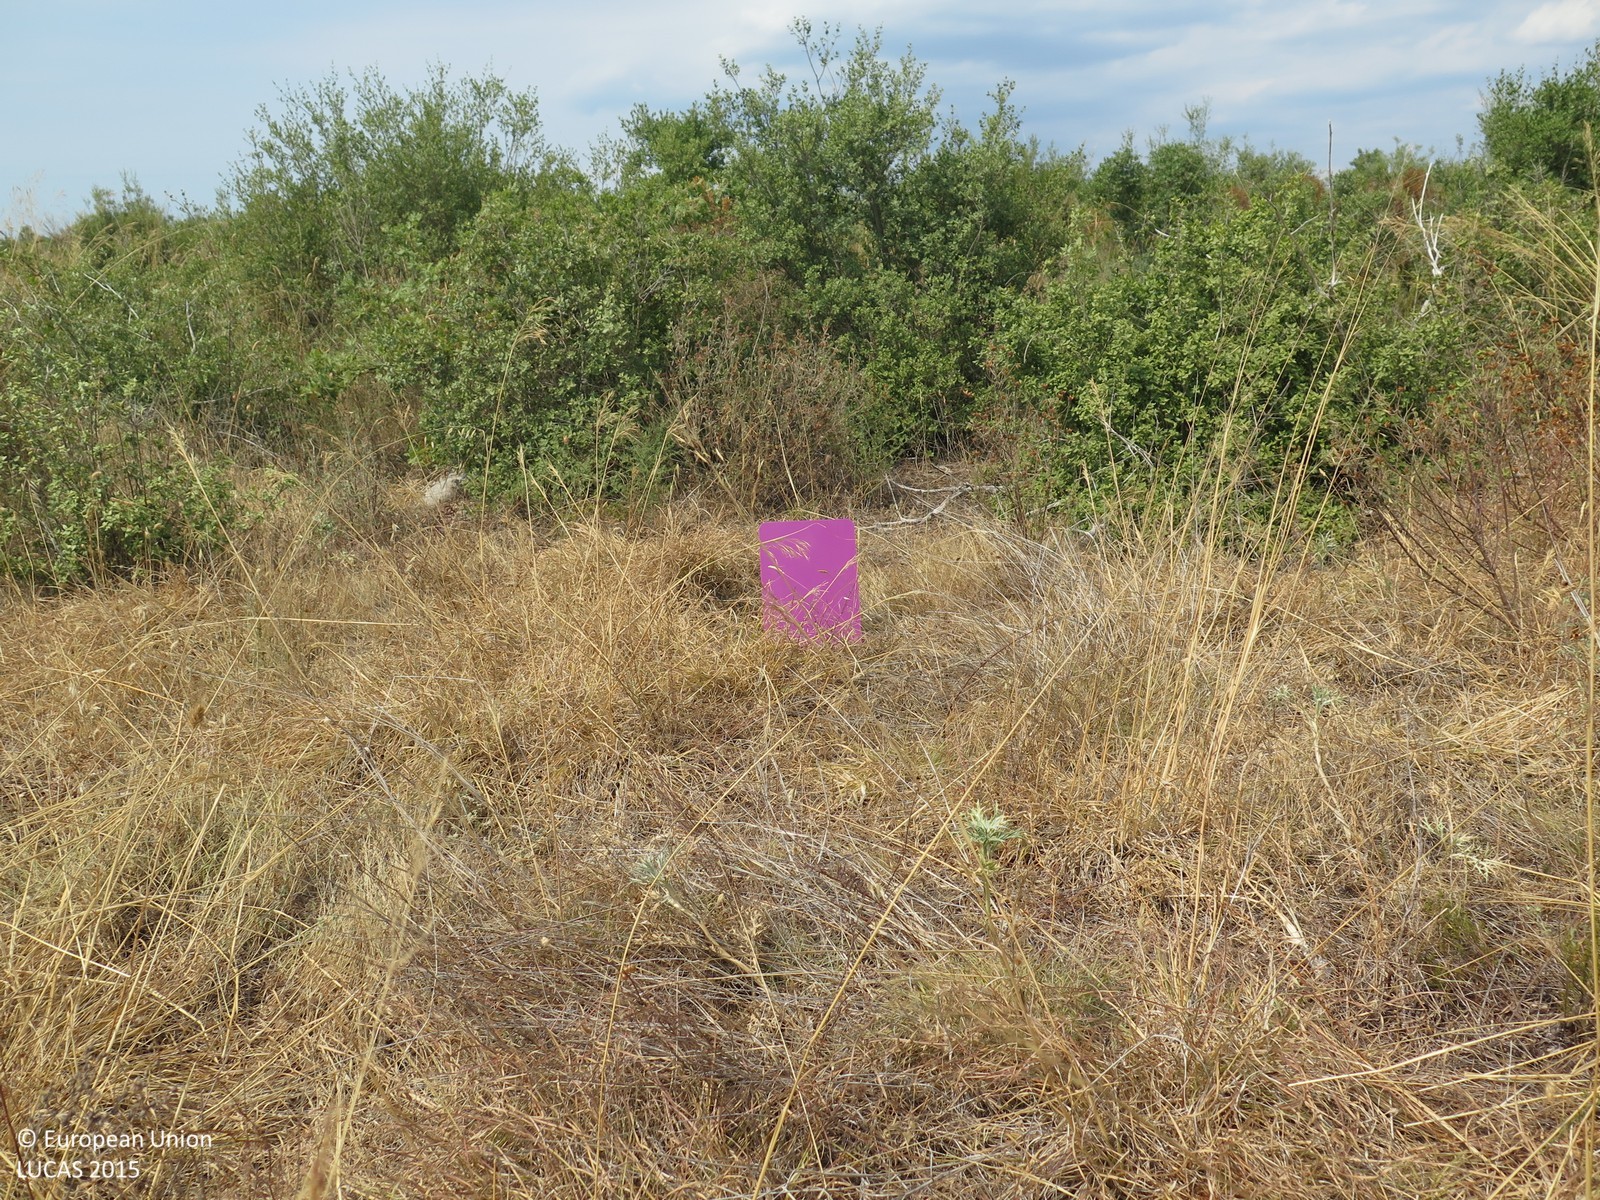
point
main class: Shrubland
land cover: Shrubland with sparse tree cover
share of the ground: > 75 %
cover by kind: shrubs 90 %, broadleaved forest trees 5 %, herbaceous plants 5 %
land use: Semi-natural and natural areas not in use
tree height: < 5 m
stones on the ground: 10 - 25 %
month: July
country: HR
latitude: 45.0035
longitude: 13.7877
